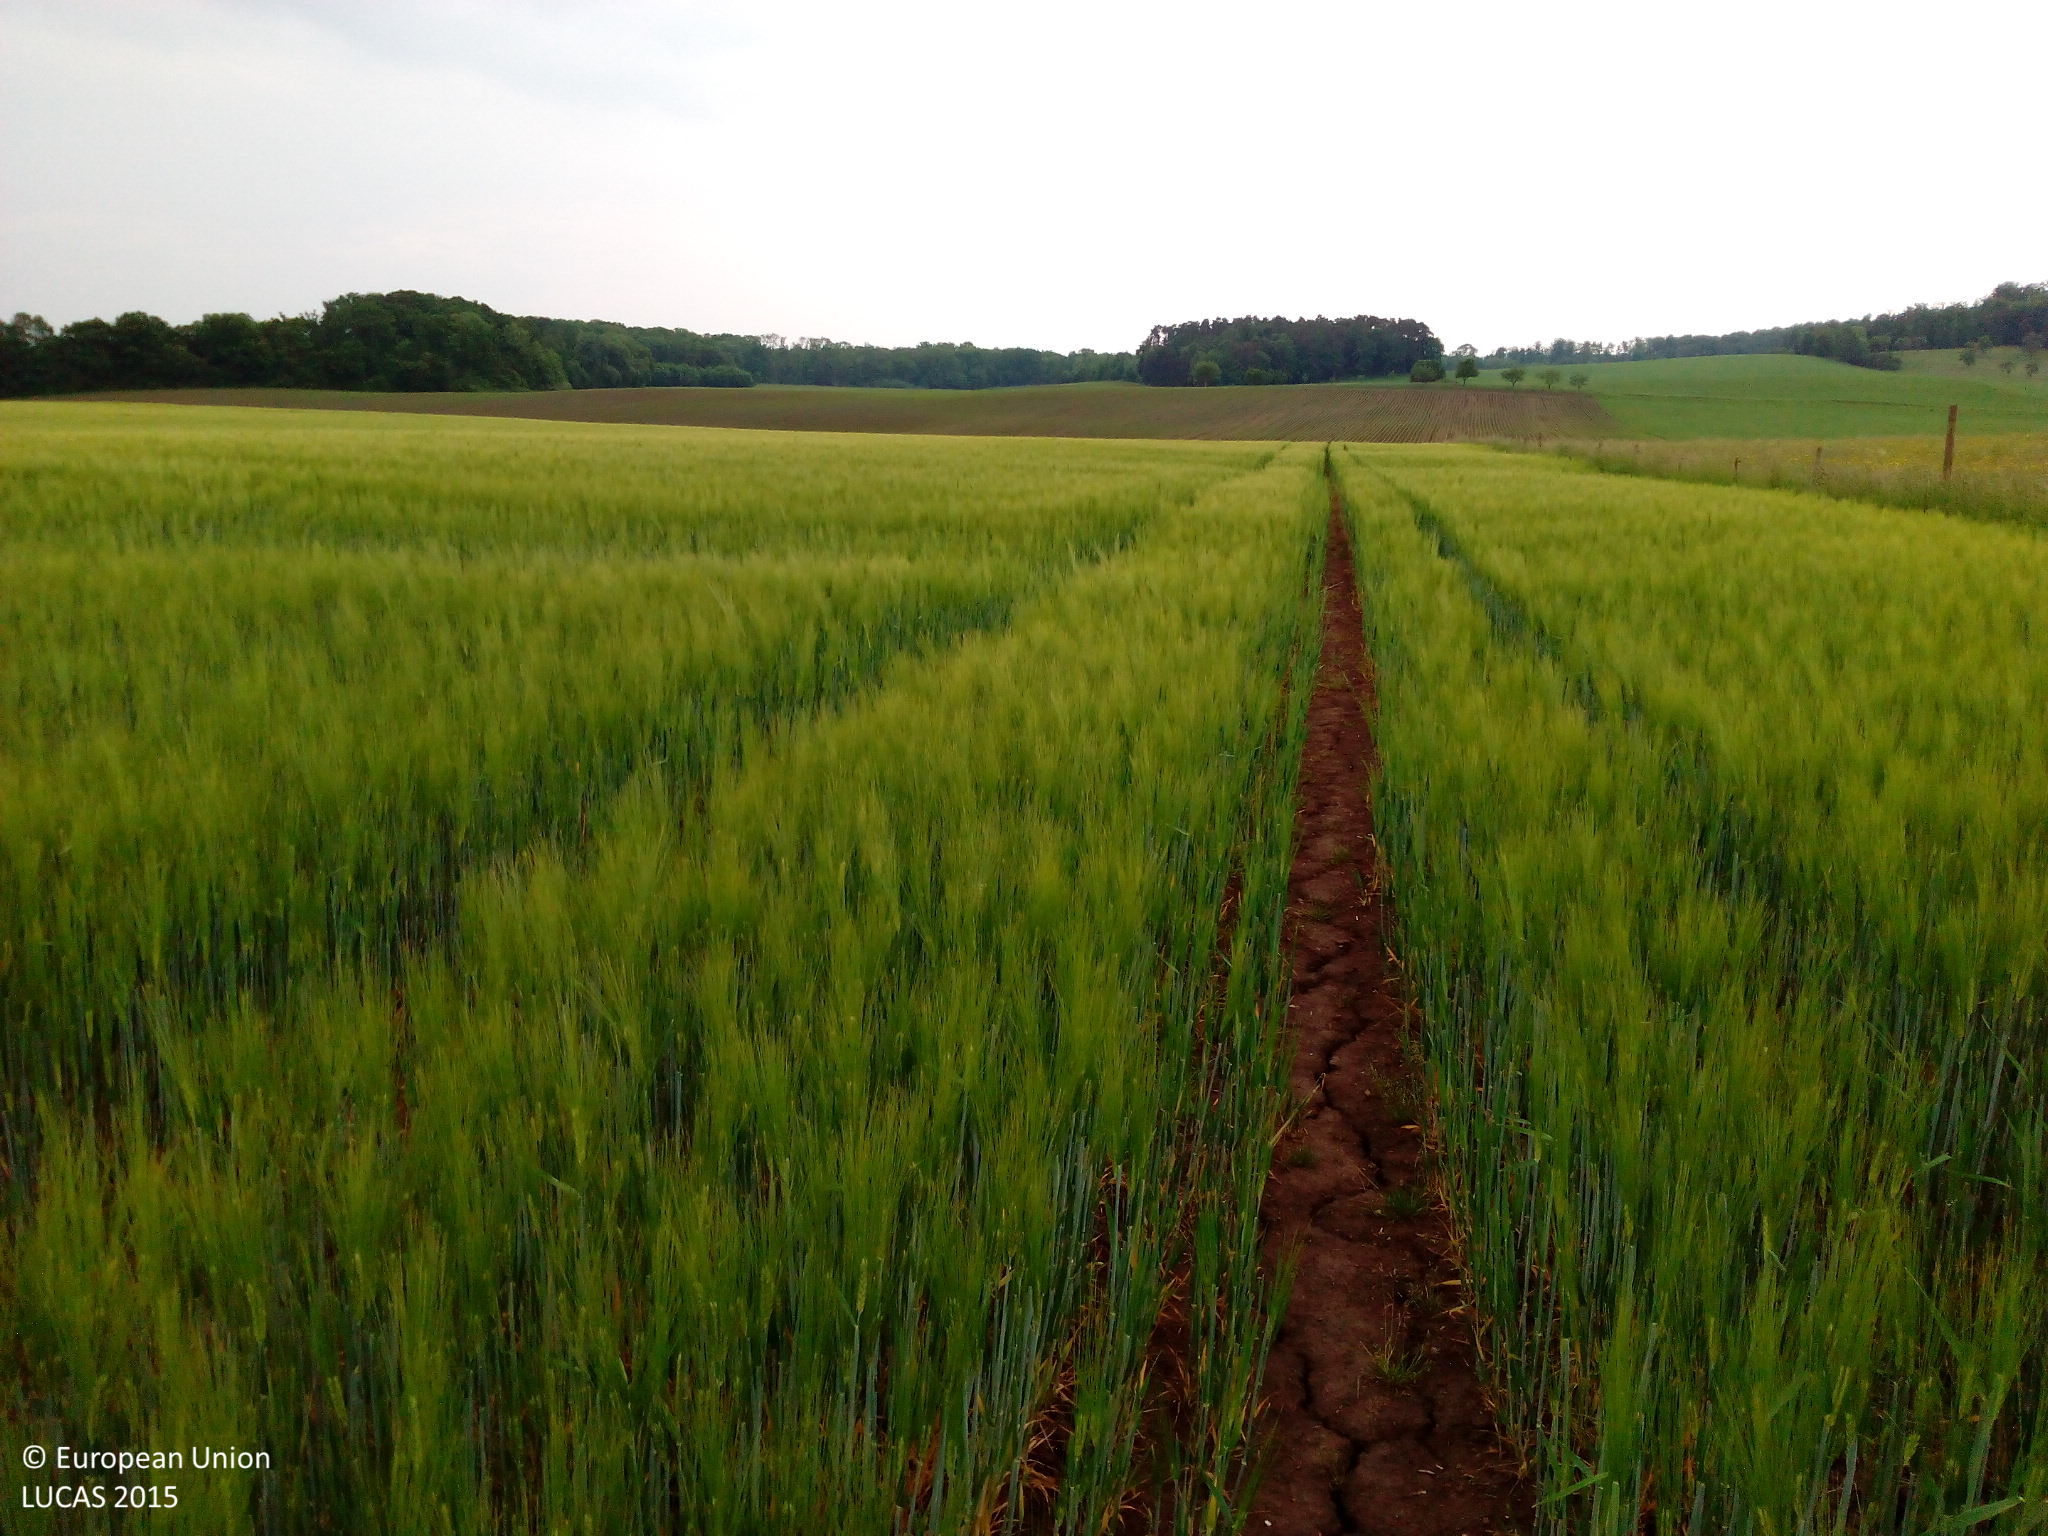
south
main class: Cropland
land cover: Barley
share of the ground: > 75 %
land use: Agriculture (excluding fallow land and kitchen gardens)
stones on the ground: < 10 %
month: May
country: DE
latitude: 49.1766
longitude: 9.6846
